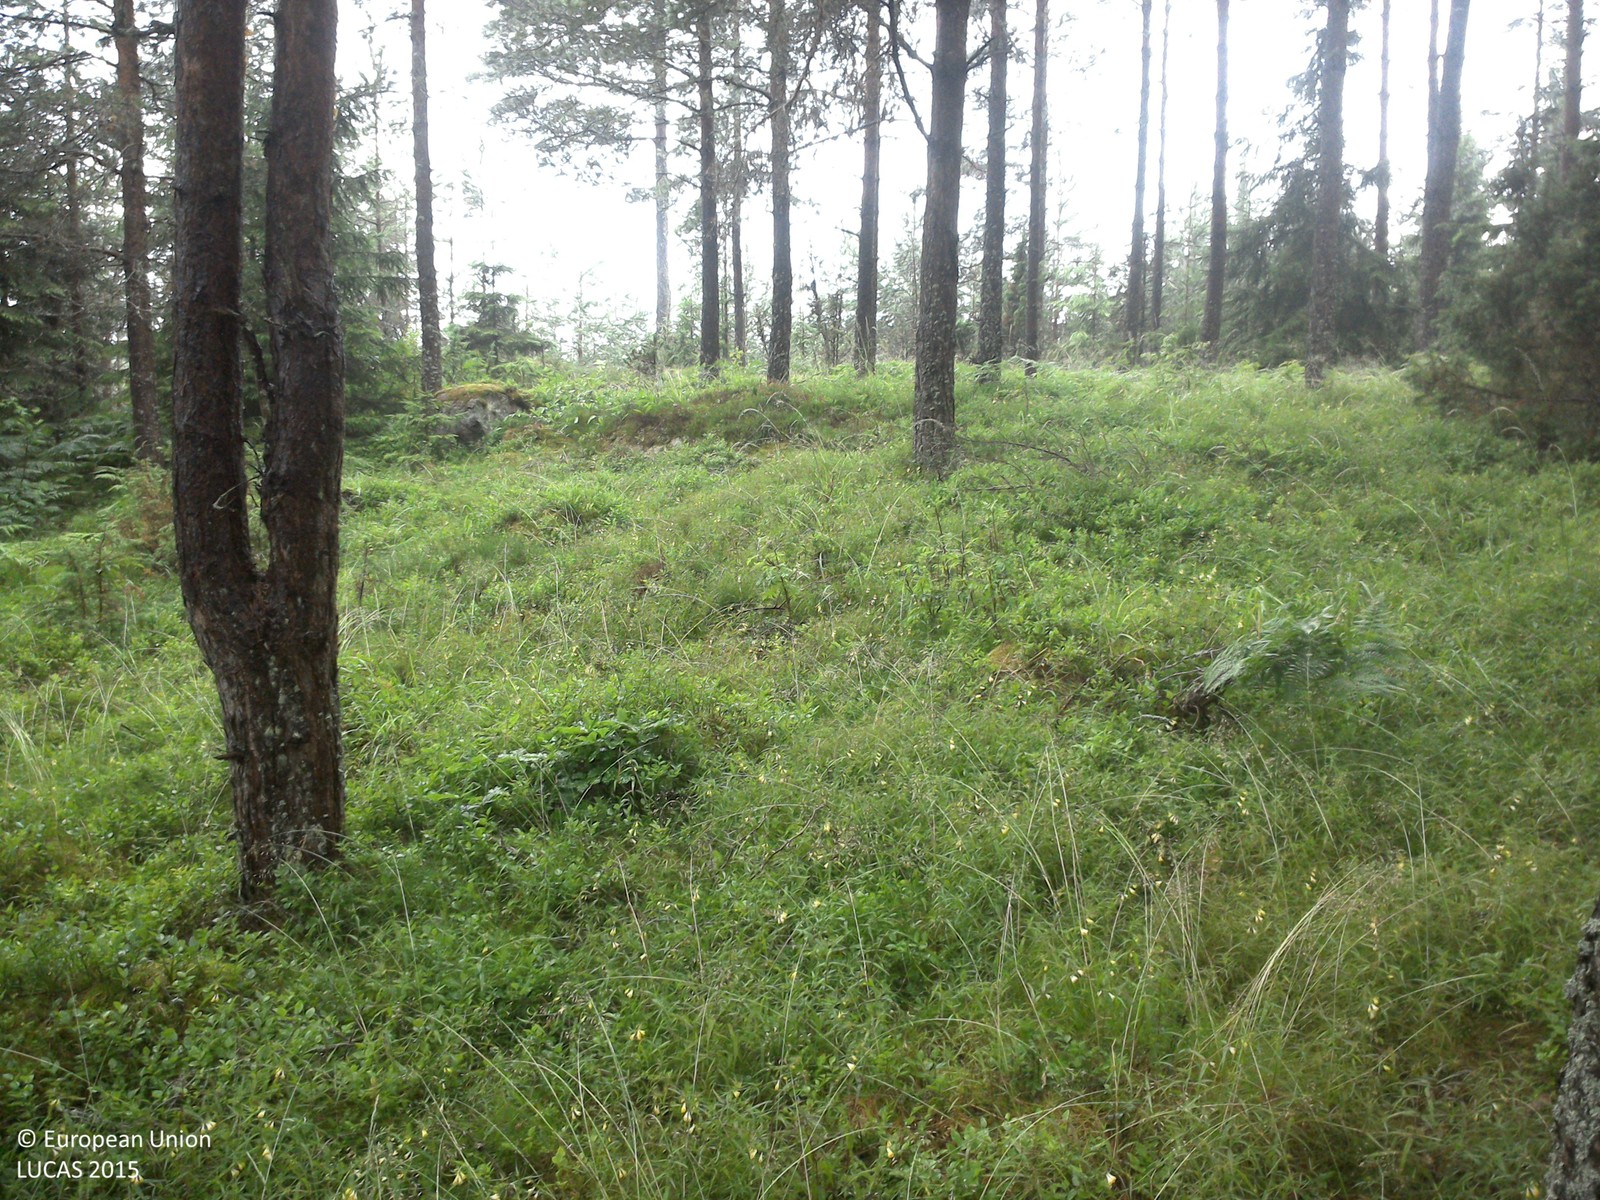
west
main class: Woodland
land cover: Pine dominated coniferous woodland
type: boreal forest
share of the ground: > 75 %
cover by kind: coniferous forest trees 75 %, herbaceous plants 25 %
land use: Forestry
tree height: > 5 m
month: July
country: SE
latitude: 58.6093
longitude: 15.1057
